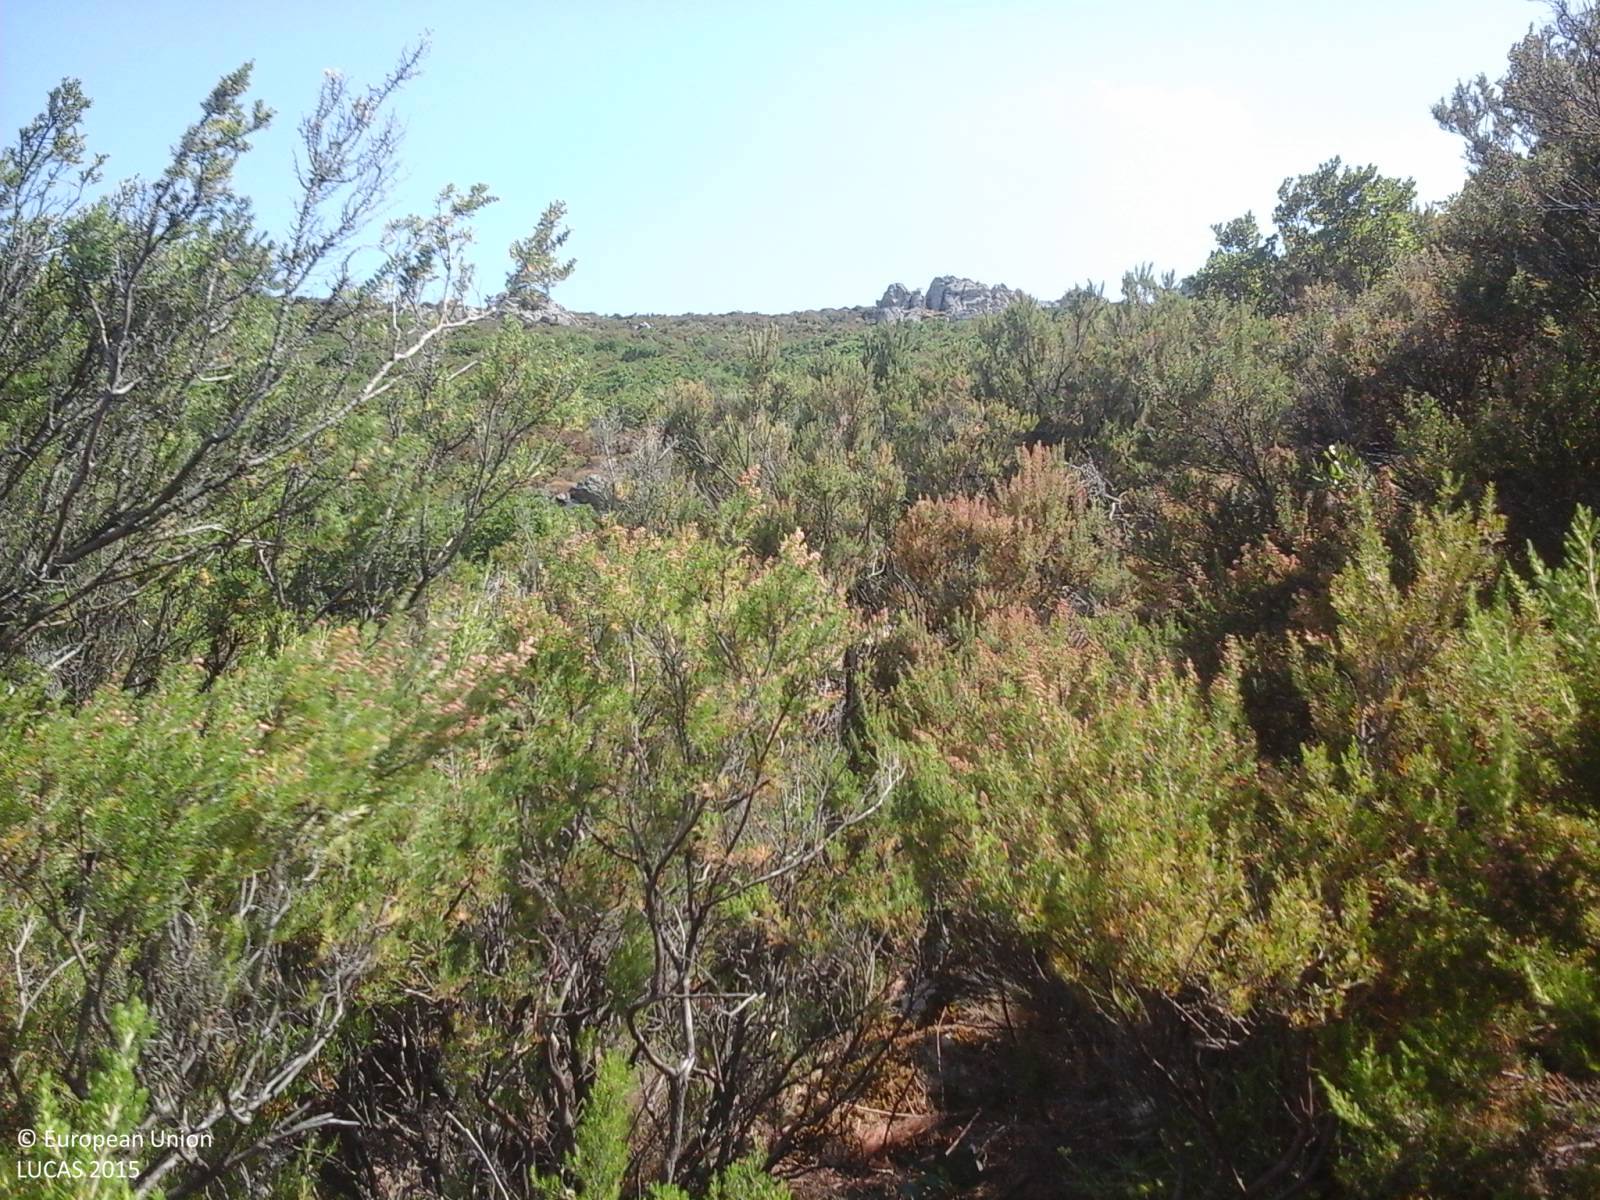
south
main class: Shrubland
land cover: Shrubland without tree cover
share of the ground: > 75 %
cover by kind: shrubs 95 %, herbaceous plants 5 %
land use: Semi-natural and natural areas not in use
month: June
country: IT
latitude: 40.5744
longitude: 9.6356
